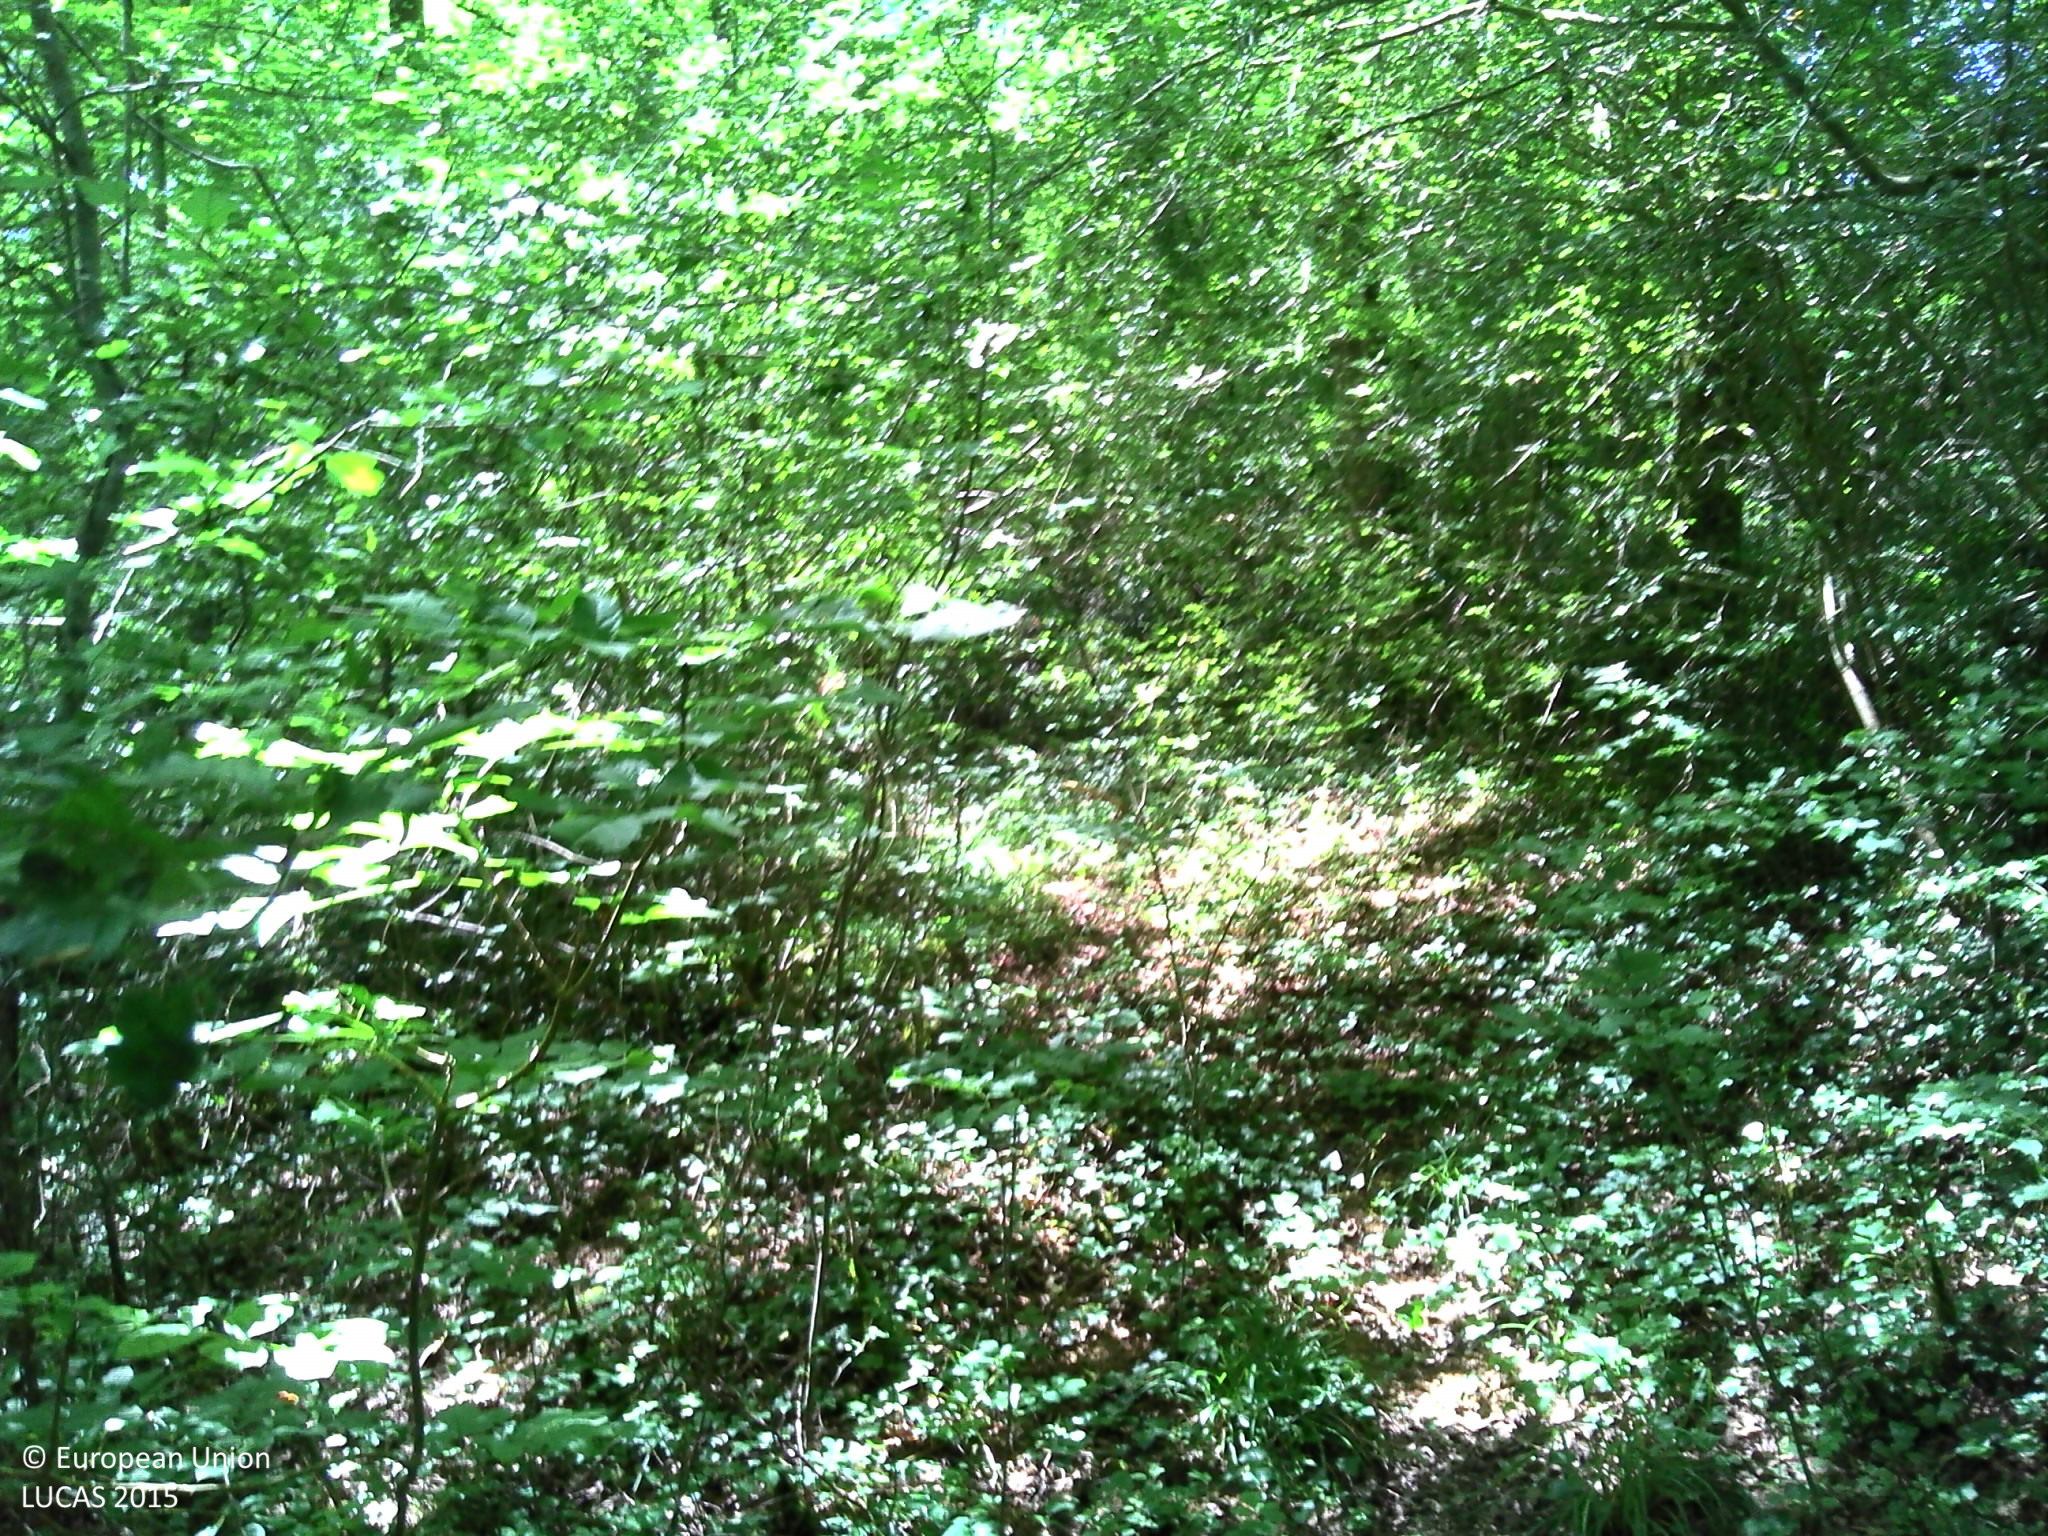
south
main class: Woodland
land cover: Broadleaved woodland
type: mesophytic deciduous forest
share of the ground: > 75 %
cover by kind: broadleaved forest trees 95 %, herbaceous plants 5 %
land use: Semi-natural and natural areas not in use
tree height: > 5 m
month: June
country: FR
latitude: 44.7862
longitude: 1.7956
